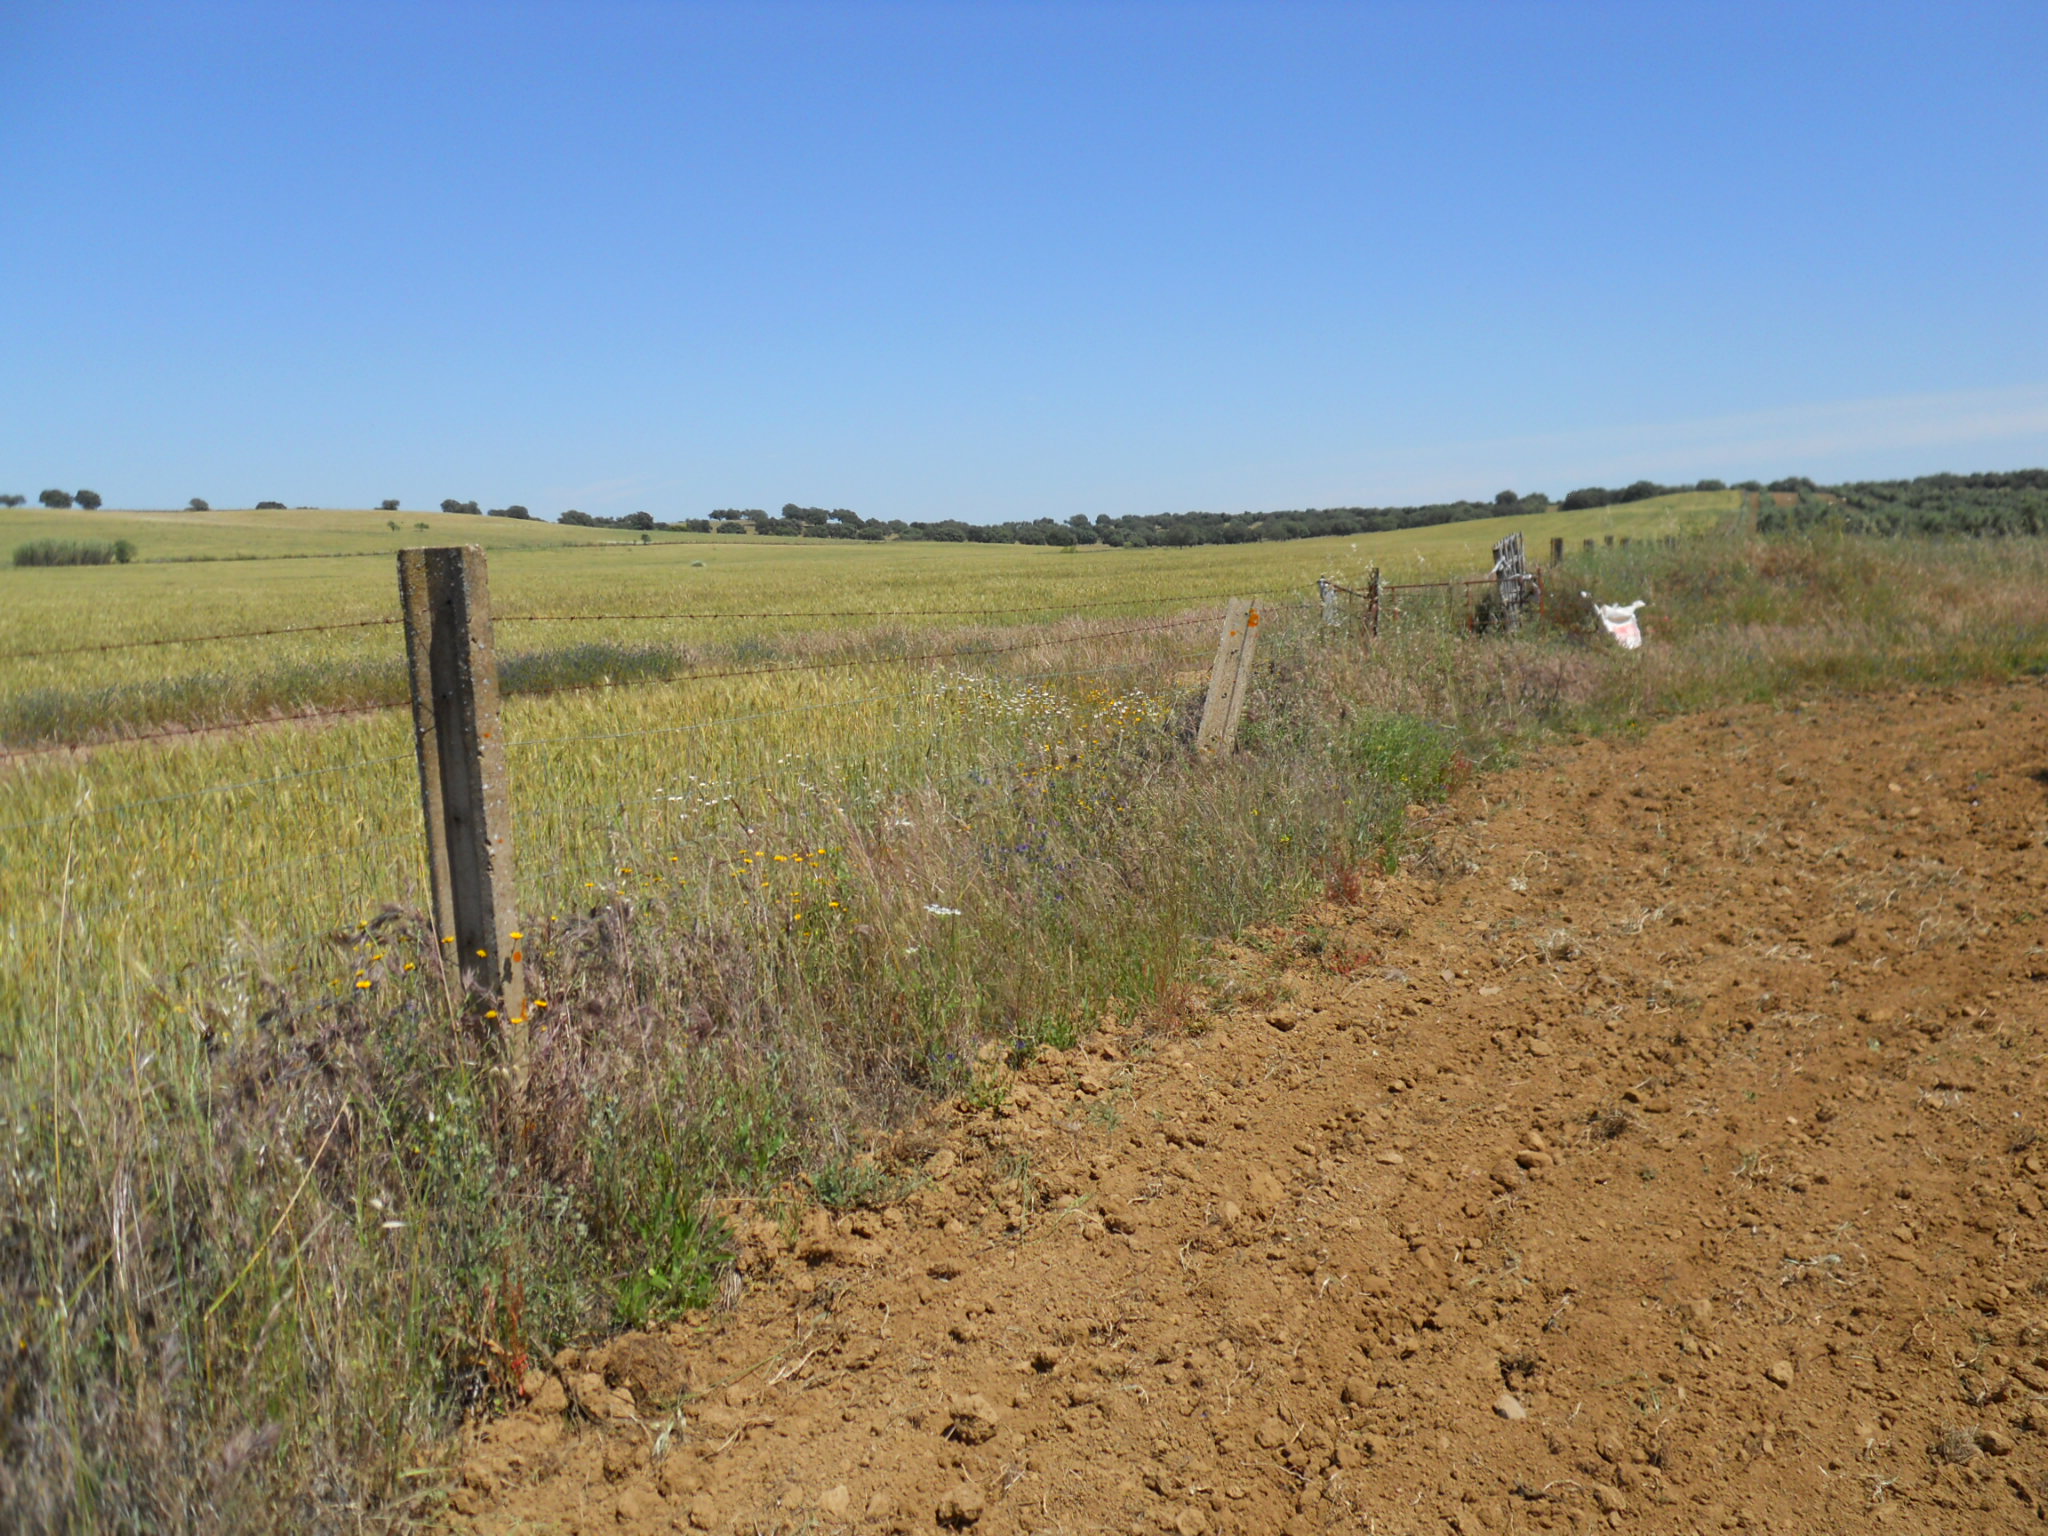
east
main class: Cropland
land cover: Olive groves
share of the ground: 10 - 25 %
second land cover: Other bare soil
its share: > 75 %
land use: Agriculture (excluding fallow land and kitchen gardens)
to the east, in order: Olive groves; Other bare soil; Fences; Common wheat; Tracks; Common wheat
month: May
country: ES
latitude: 39.0312
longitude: -6.5717
